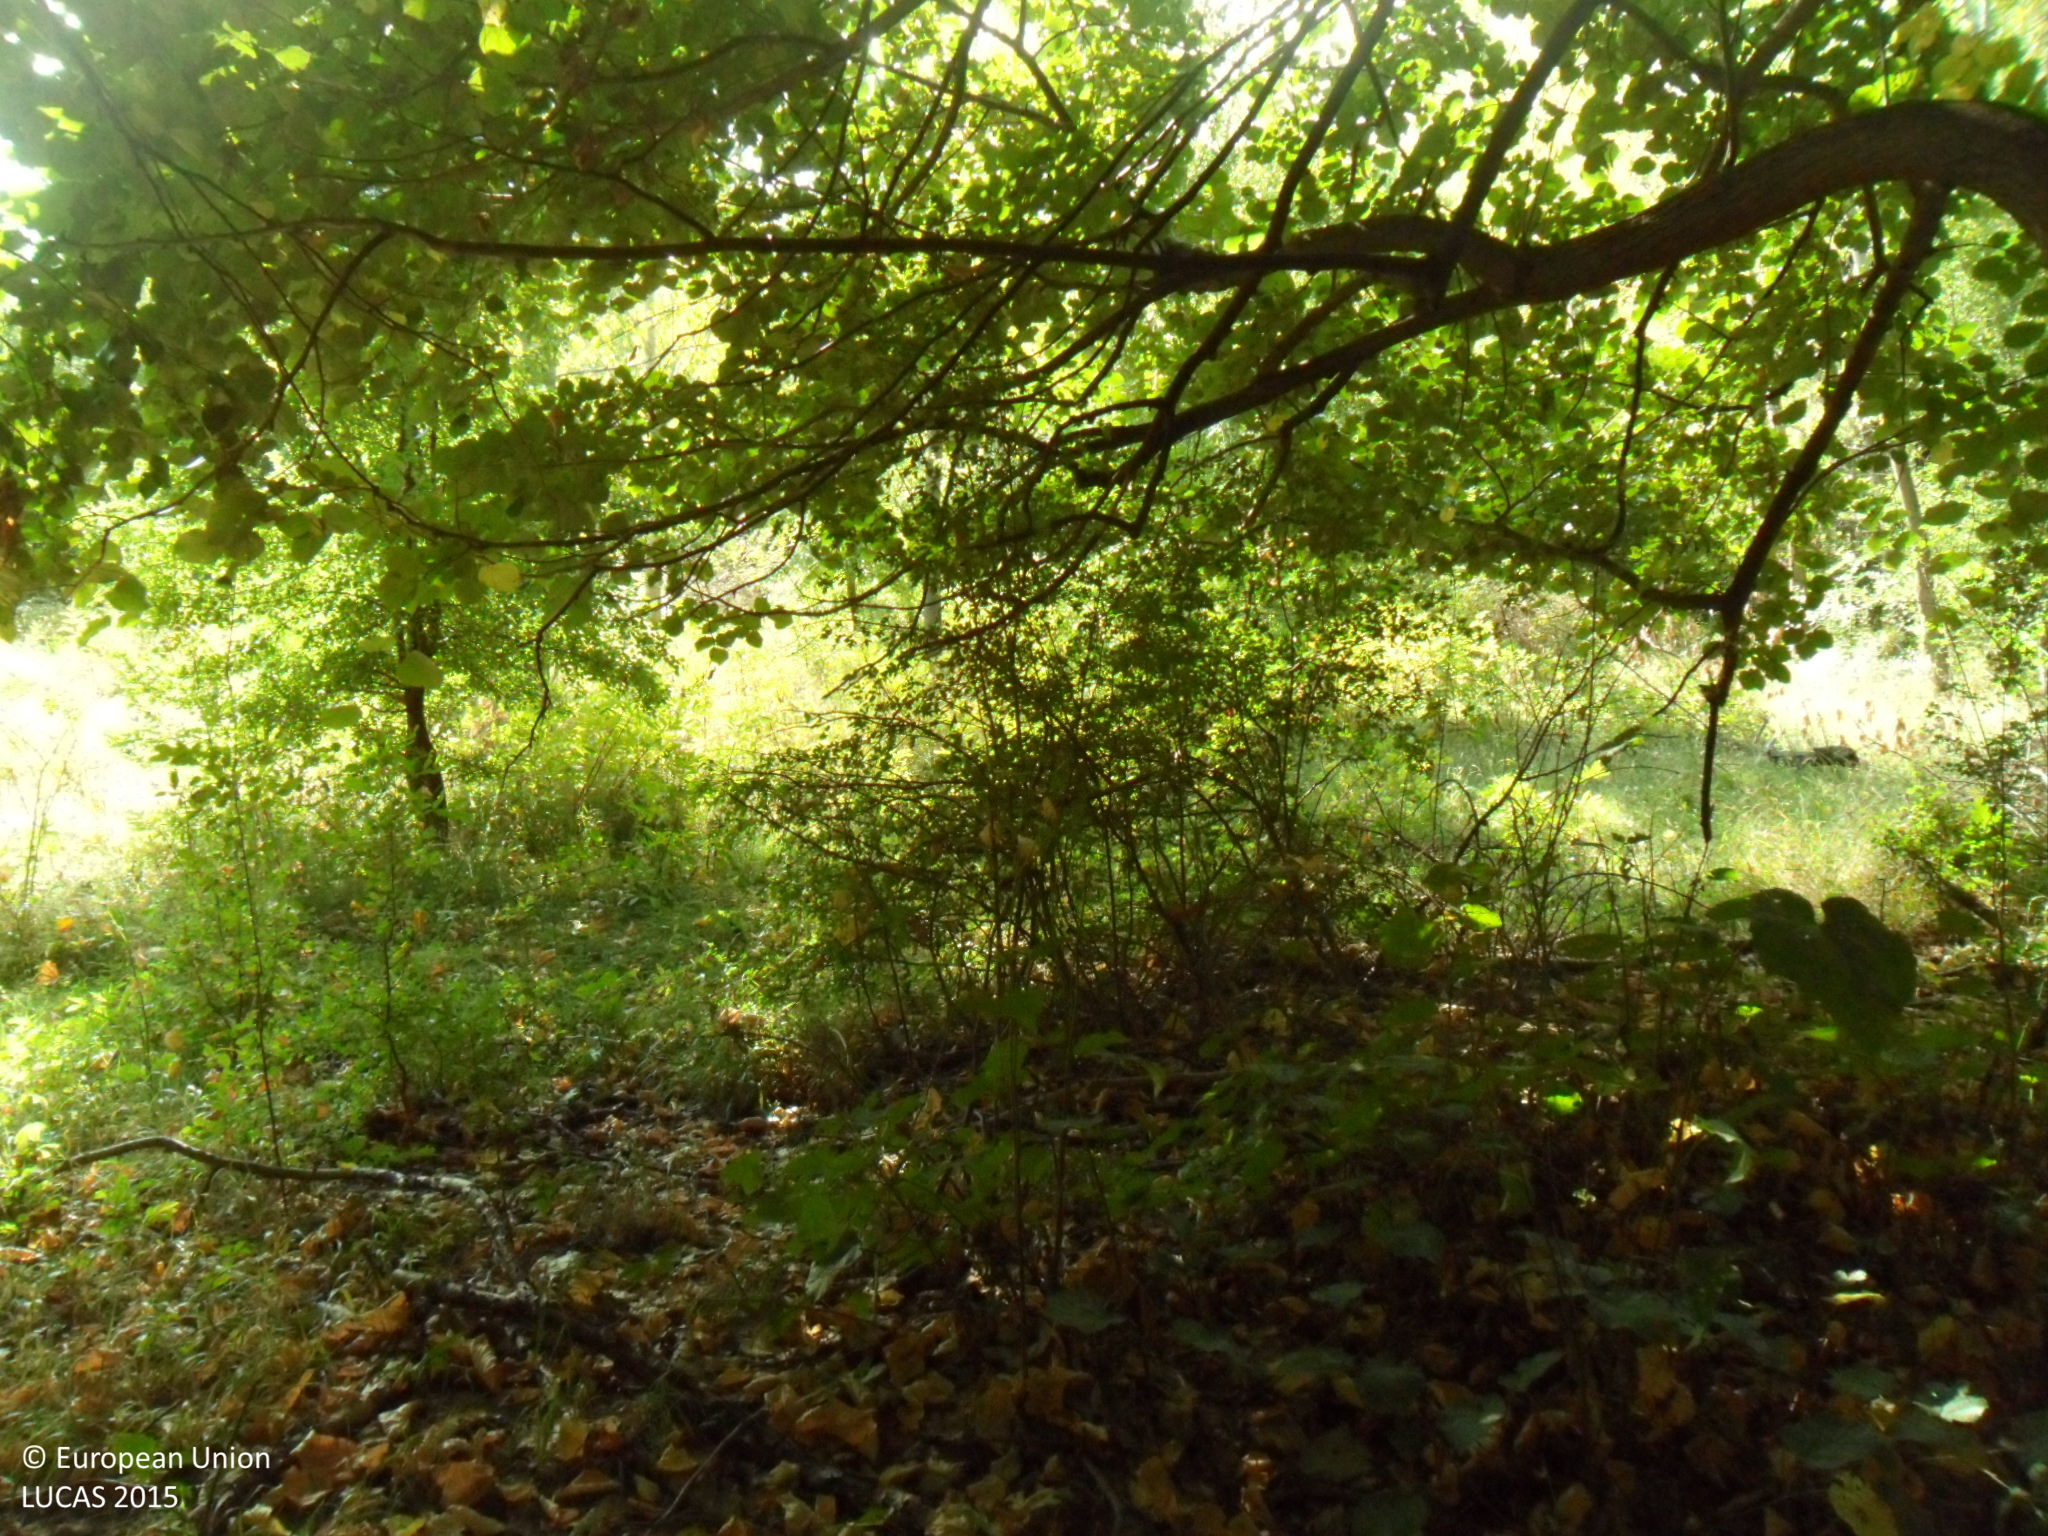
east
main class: Woodland
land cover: Broadleaved woodland
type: beech forest
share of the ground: > 75 %
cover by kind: broadleaved forest trees 95 %, unconsolidated bare surface 5 %
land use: Forestry
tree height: > 5 m
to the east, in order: Broadleaved woodland; Tracks; Grassland with sparse tree/shrub cover; Broadleaved woodland
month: September
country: BG
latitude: 43.9117
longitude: 26.4328
